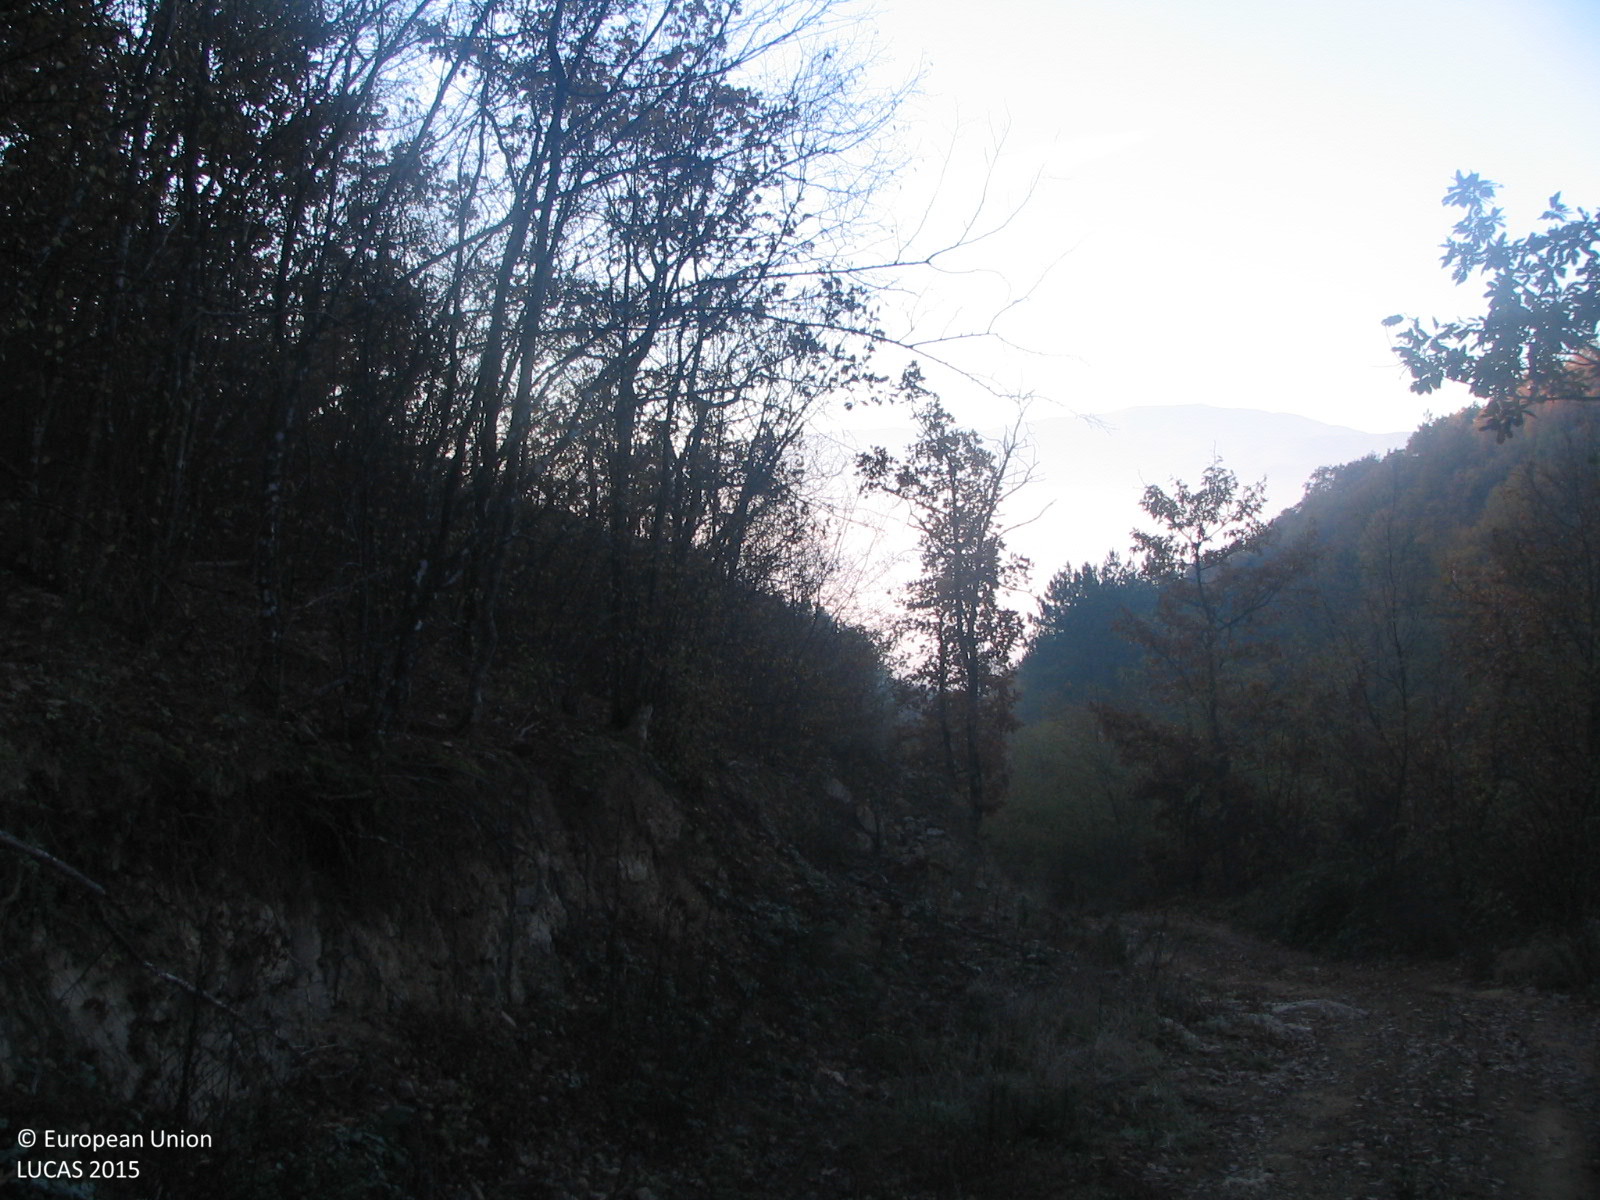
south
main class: Woodland
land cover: Broadleaved woodland
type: acidophilous oak and oak-birch forest
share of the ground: > 75 %
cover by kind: broadleaved forest trees 90 %, shrubs 5 %, herbaceous plants 5 %
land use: Forestry
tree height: > 5 m
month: November
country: BG
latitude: 42.9923
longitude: 23.7438
